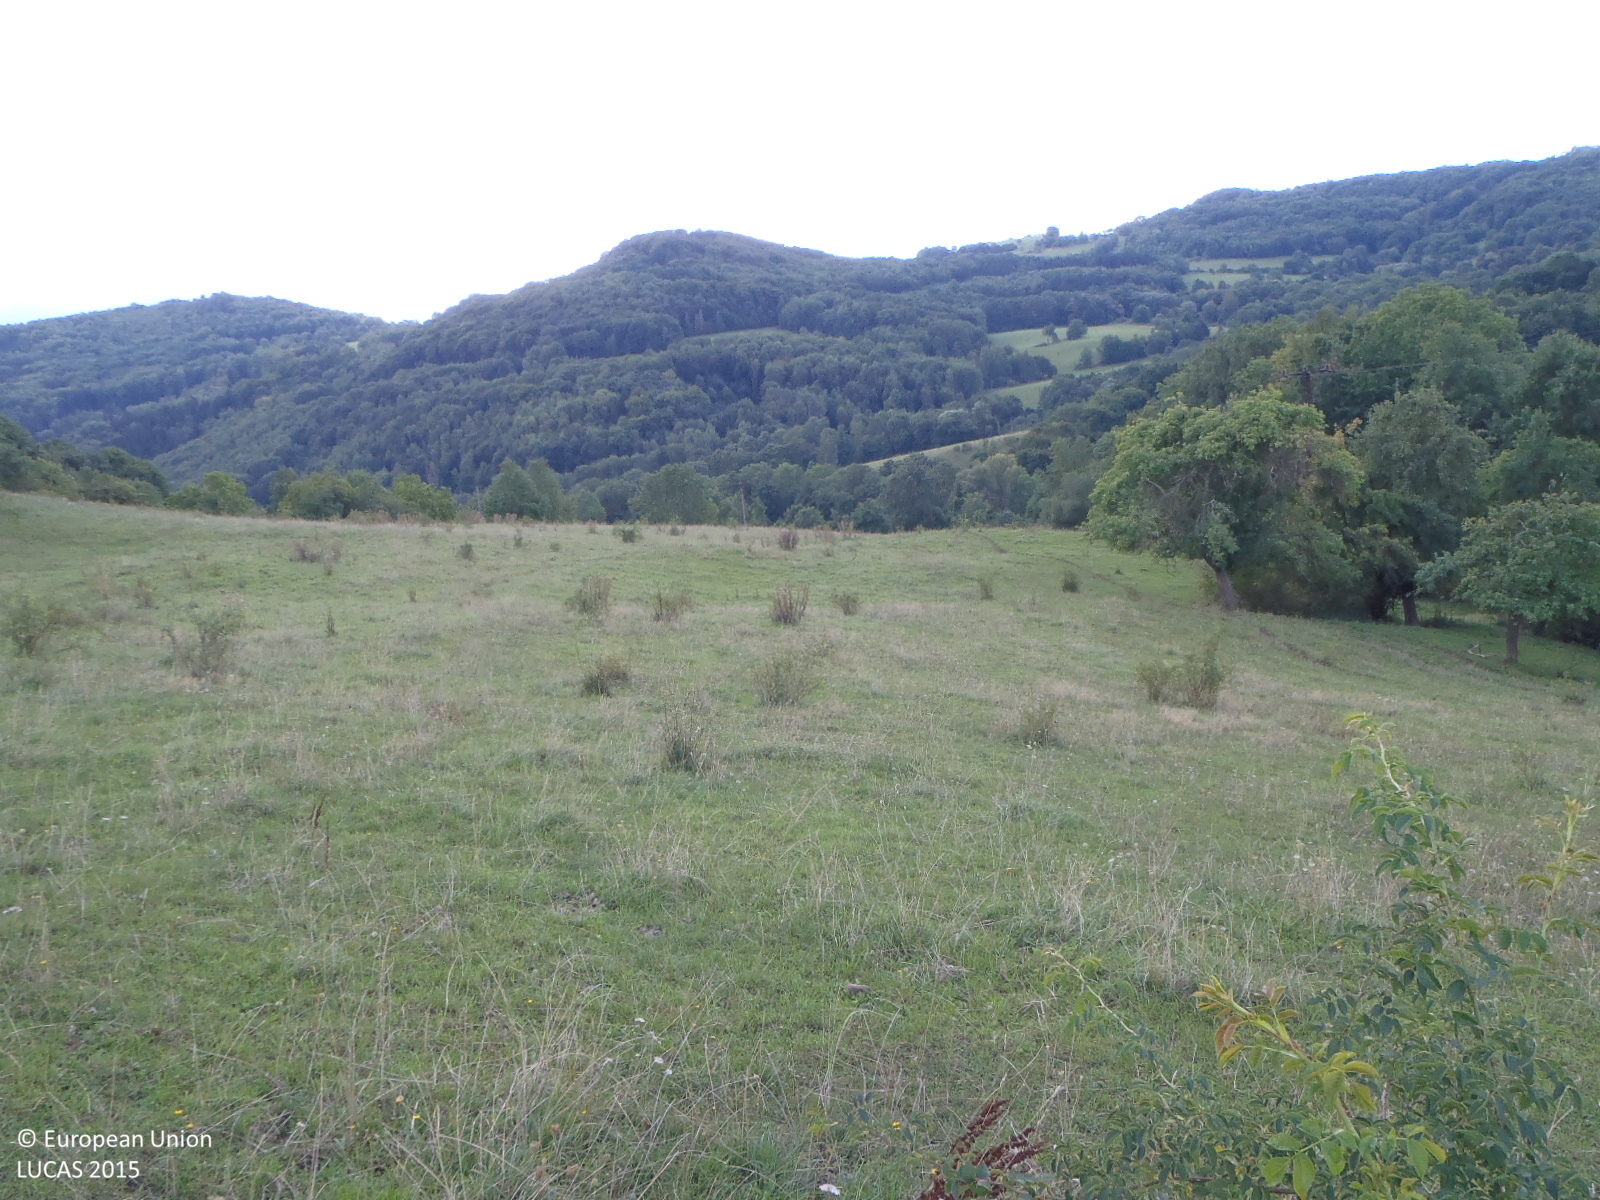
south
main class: Grassland
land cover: Grassland with sparse tree/shrub cover
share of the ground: > 75 %
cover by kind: herbaceous plants 95 %, broadleaved forest trees 5 %
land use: Agriculture (excluding fallow land and kitchen gardens)
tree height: < 5 m
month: September
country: CZ
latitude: 50.7208
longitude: 14.1515
